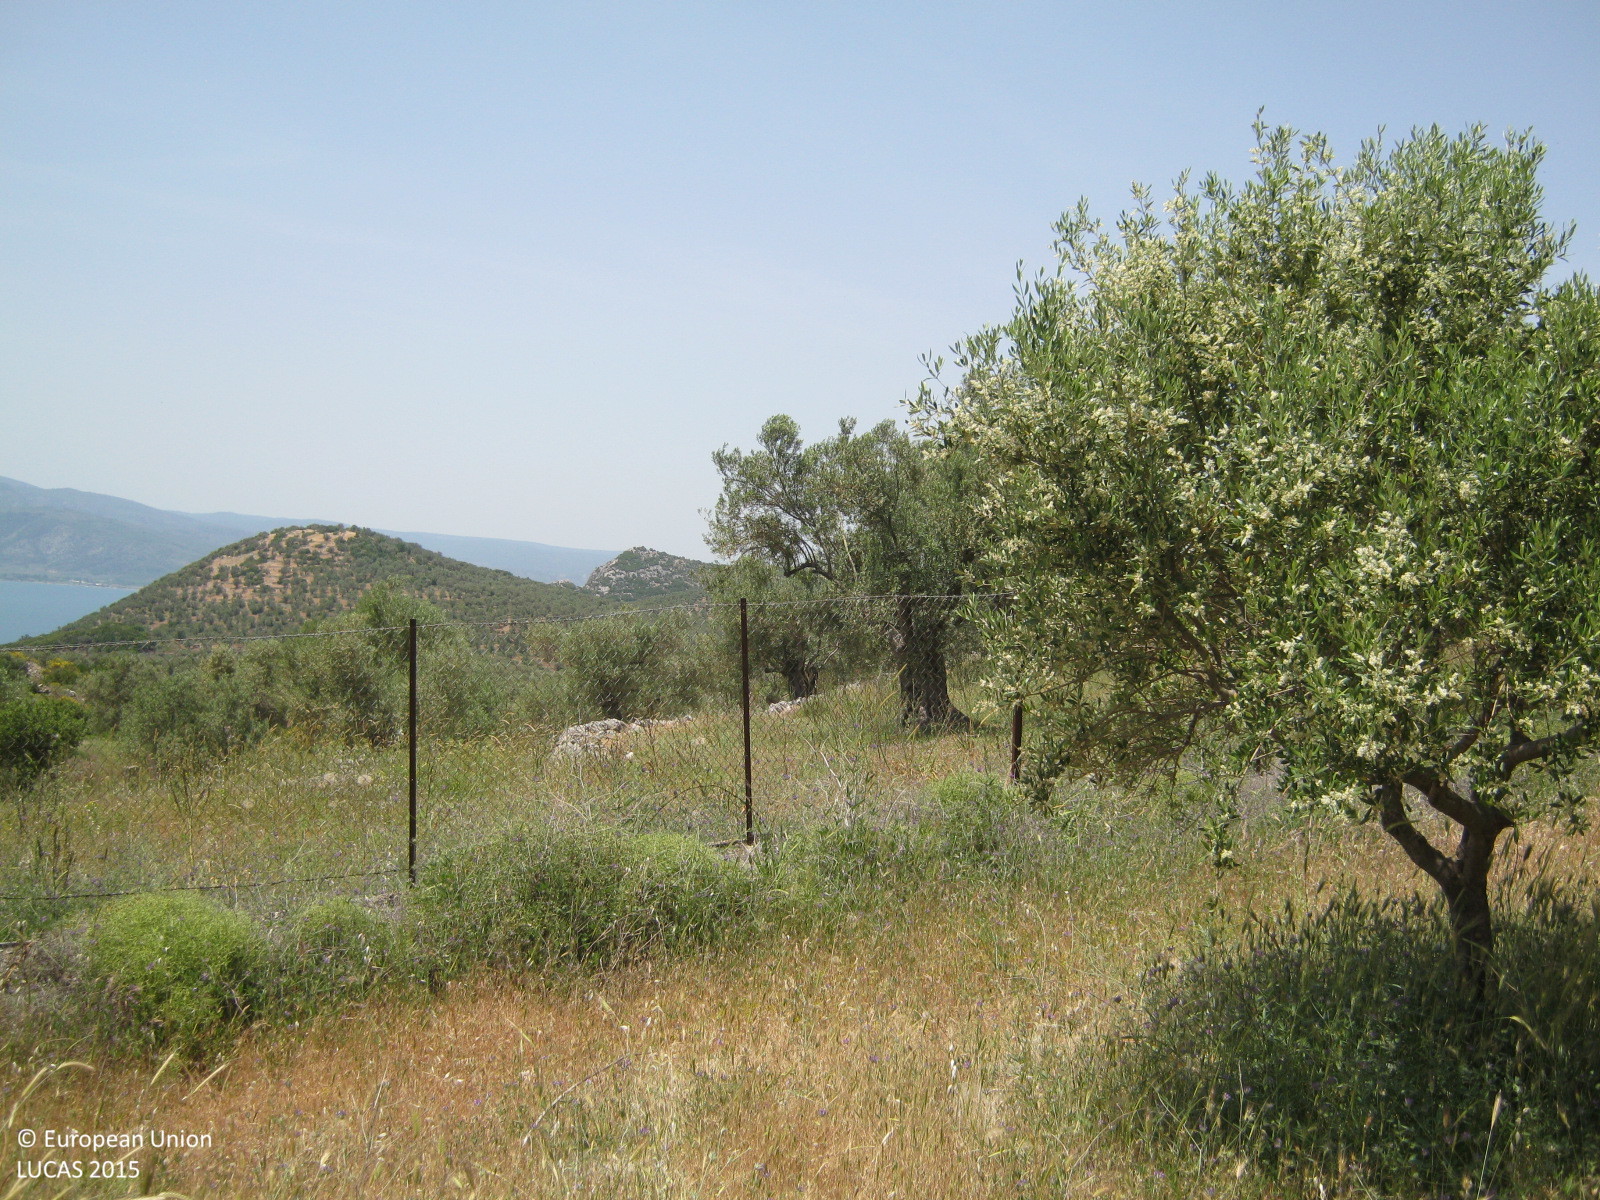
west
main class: Cropland
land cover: Olive groves
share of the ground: 10 - 25 %
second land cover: Spontaneously vegetated surfaces
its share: > 75 %
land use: Agriculture (excluding fallow land and kitchen gardens)
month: May
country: GR
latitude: 39.1135
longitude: 26.5220
